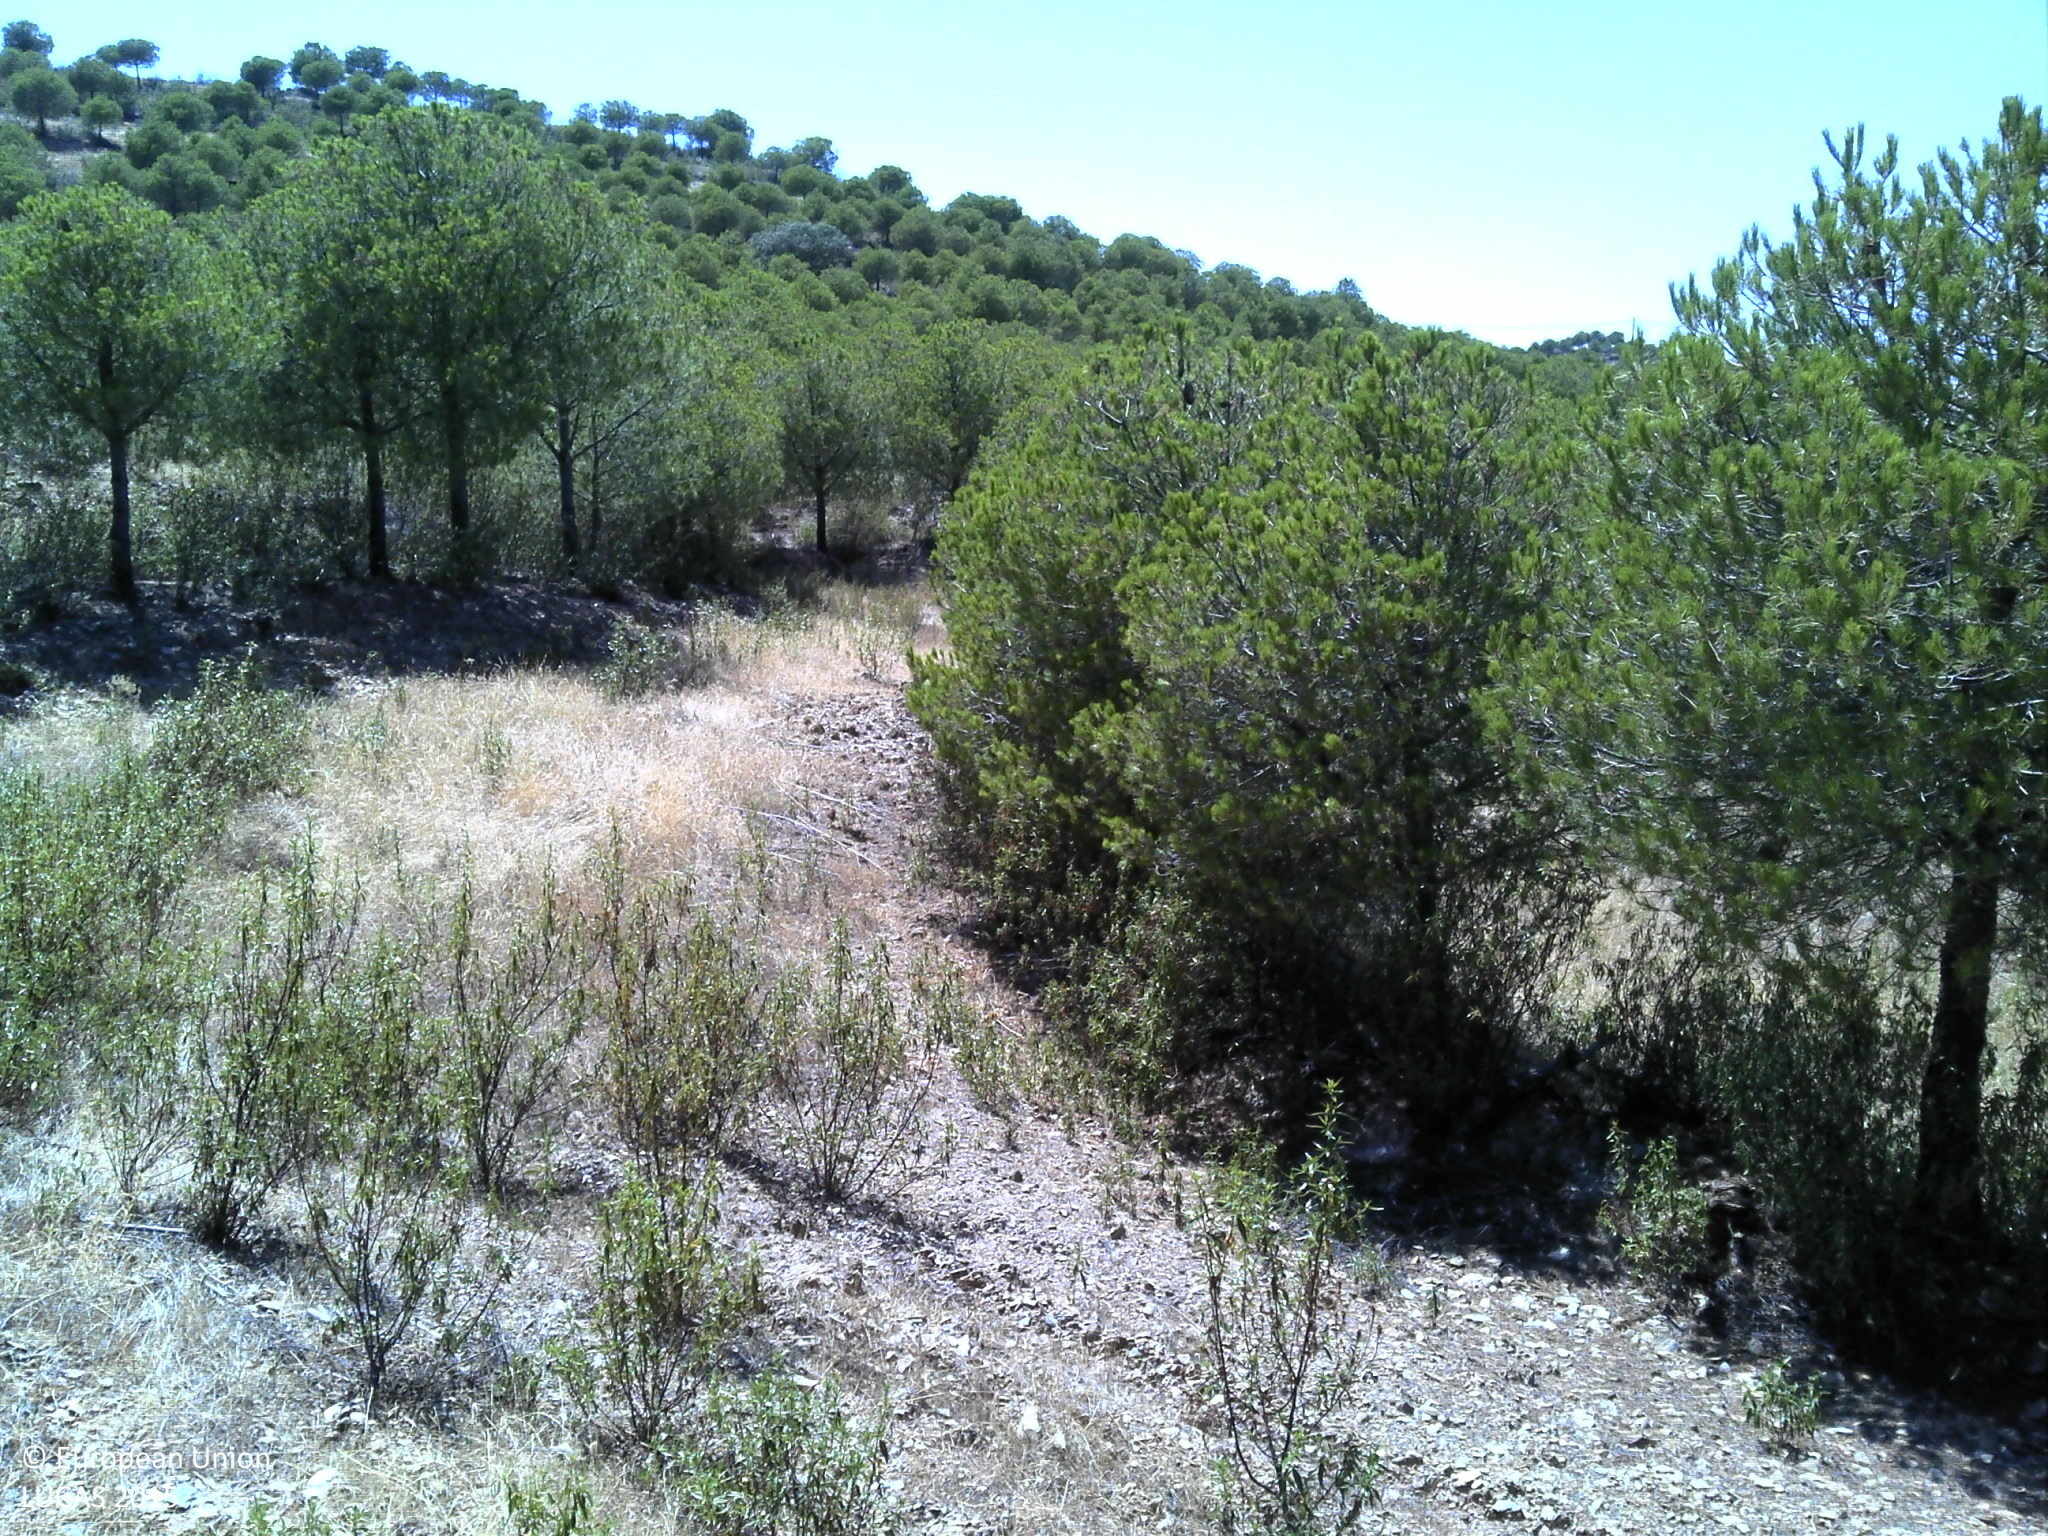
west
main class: Woodland
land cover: Pine dominated coniferous woodland
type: coniferous forest of the mediterranean region
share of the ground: 25 - 50 %
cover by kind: unconsolidated bare surface 50 %, coniferous forest trees 40 %, shrubs 10 %
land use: Forestry
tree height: < 5 m
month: July
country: PT
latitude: 37.5483
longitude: -7.8218
